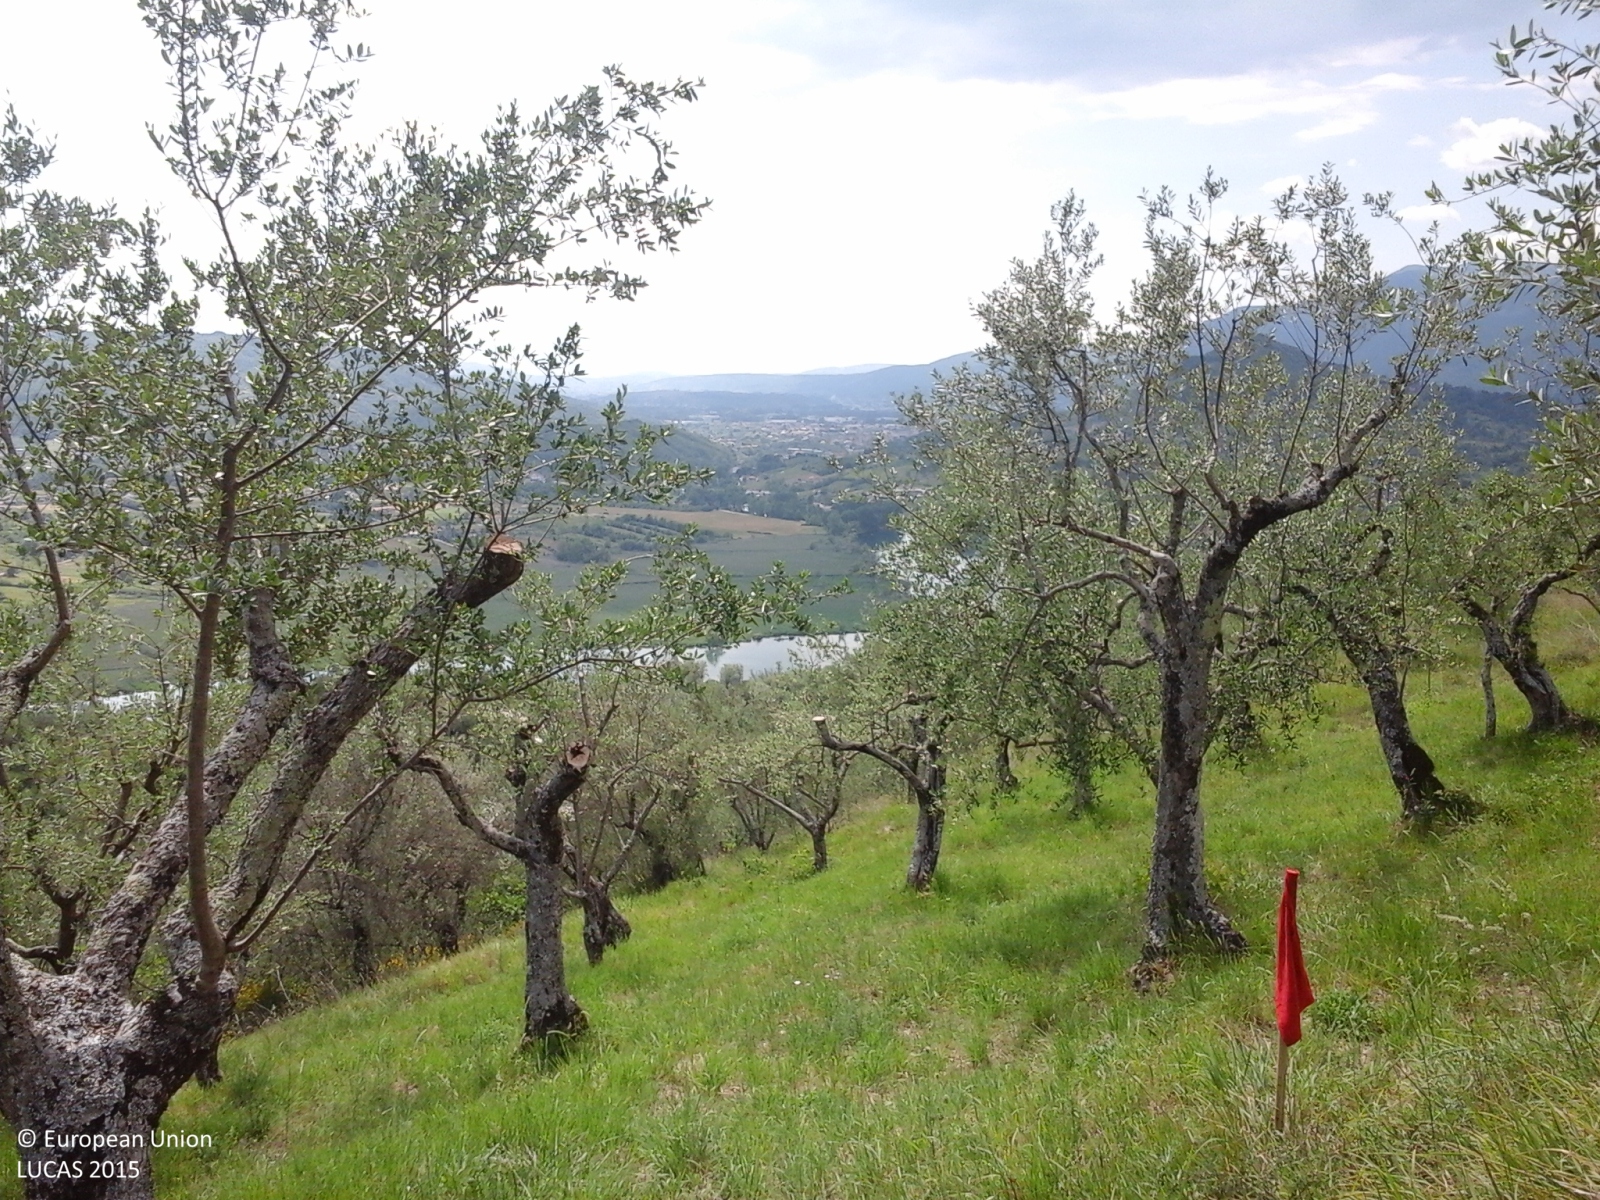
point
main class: Cropland
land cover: Olive groves
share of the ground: > 75 %
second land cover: Grassland without tree/shrub cover
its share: 50 - 75 %
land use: Agriculture (excluding fallow land and kitchen gardens)
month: June
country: IT
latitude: 41.7003
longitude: 13.6997
